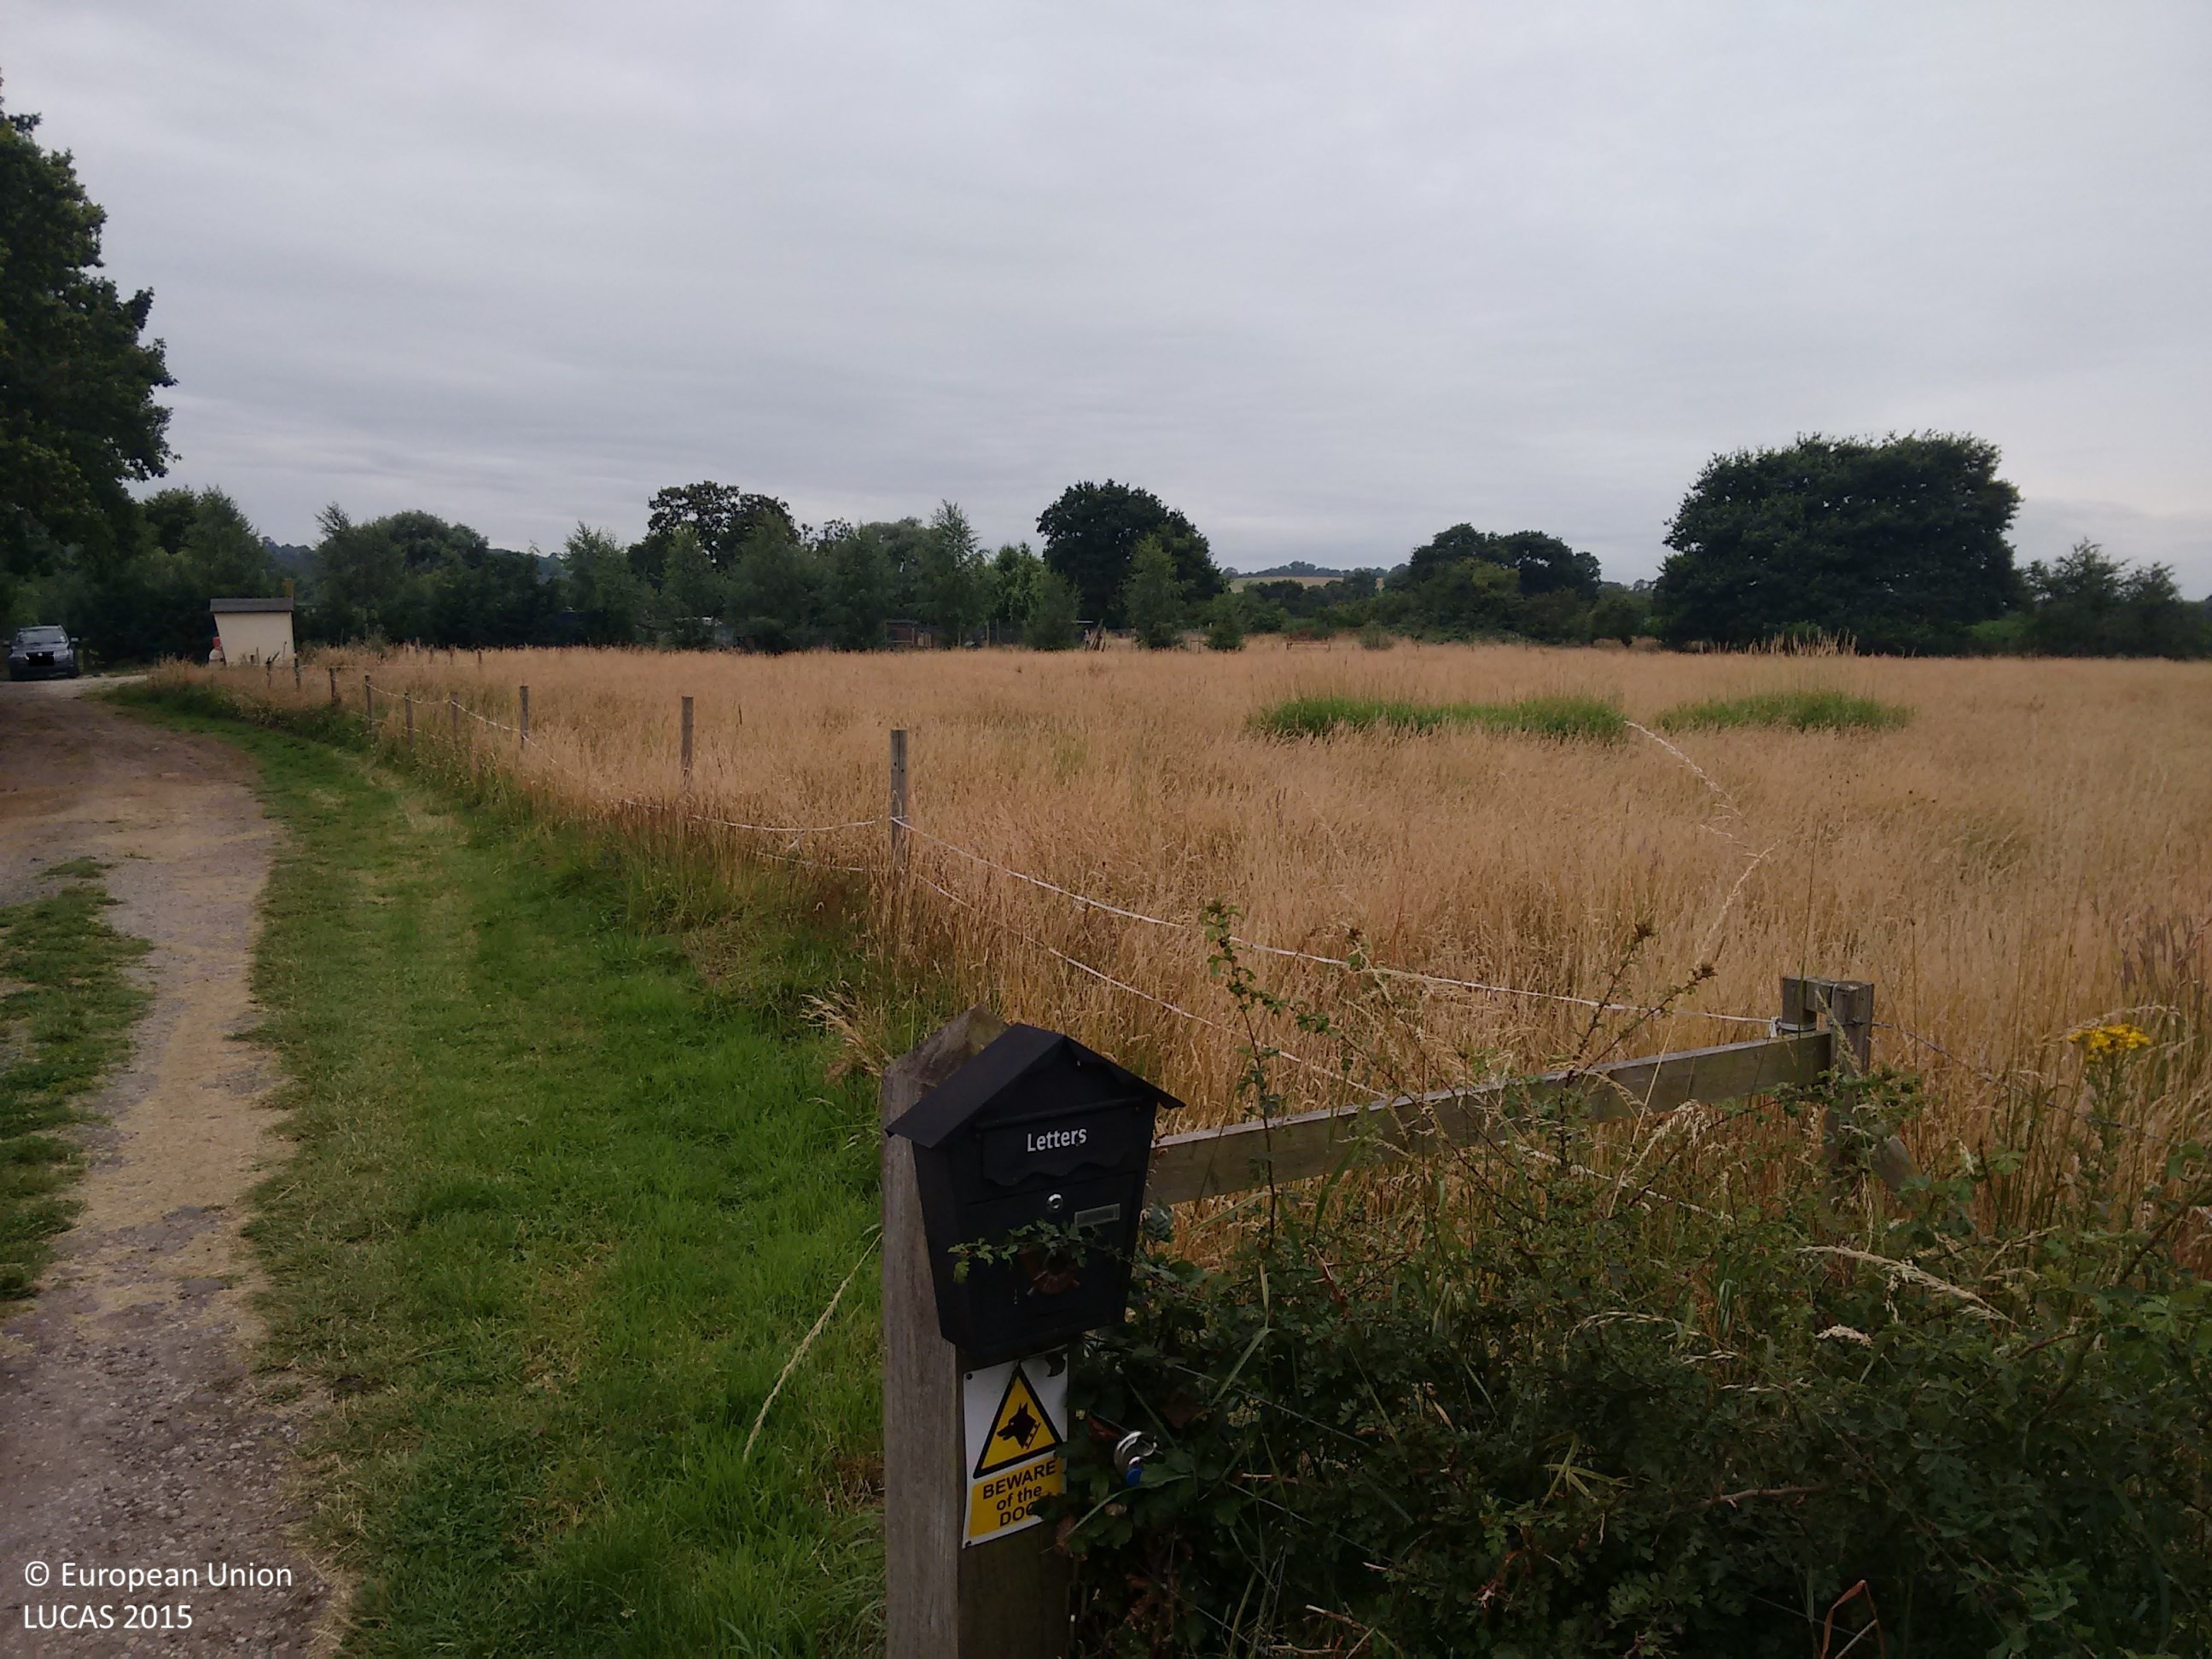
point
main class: Grassland
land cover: Grassland without tree/shrub cover
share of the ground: > 75 %
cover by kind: herbaceous plants 100 %
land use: Agriculture (excluding fallow land and kitchen gardens)
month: July
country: GB
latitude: 53.0969
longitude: -1.0206
